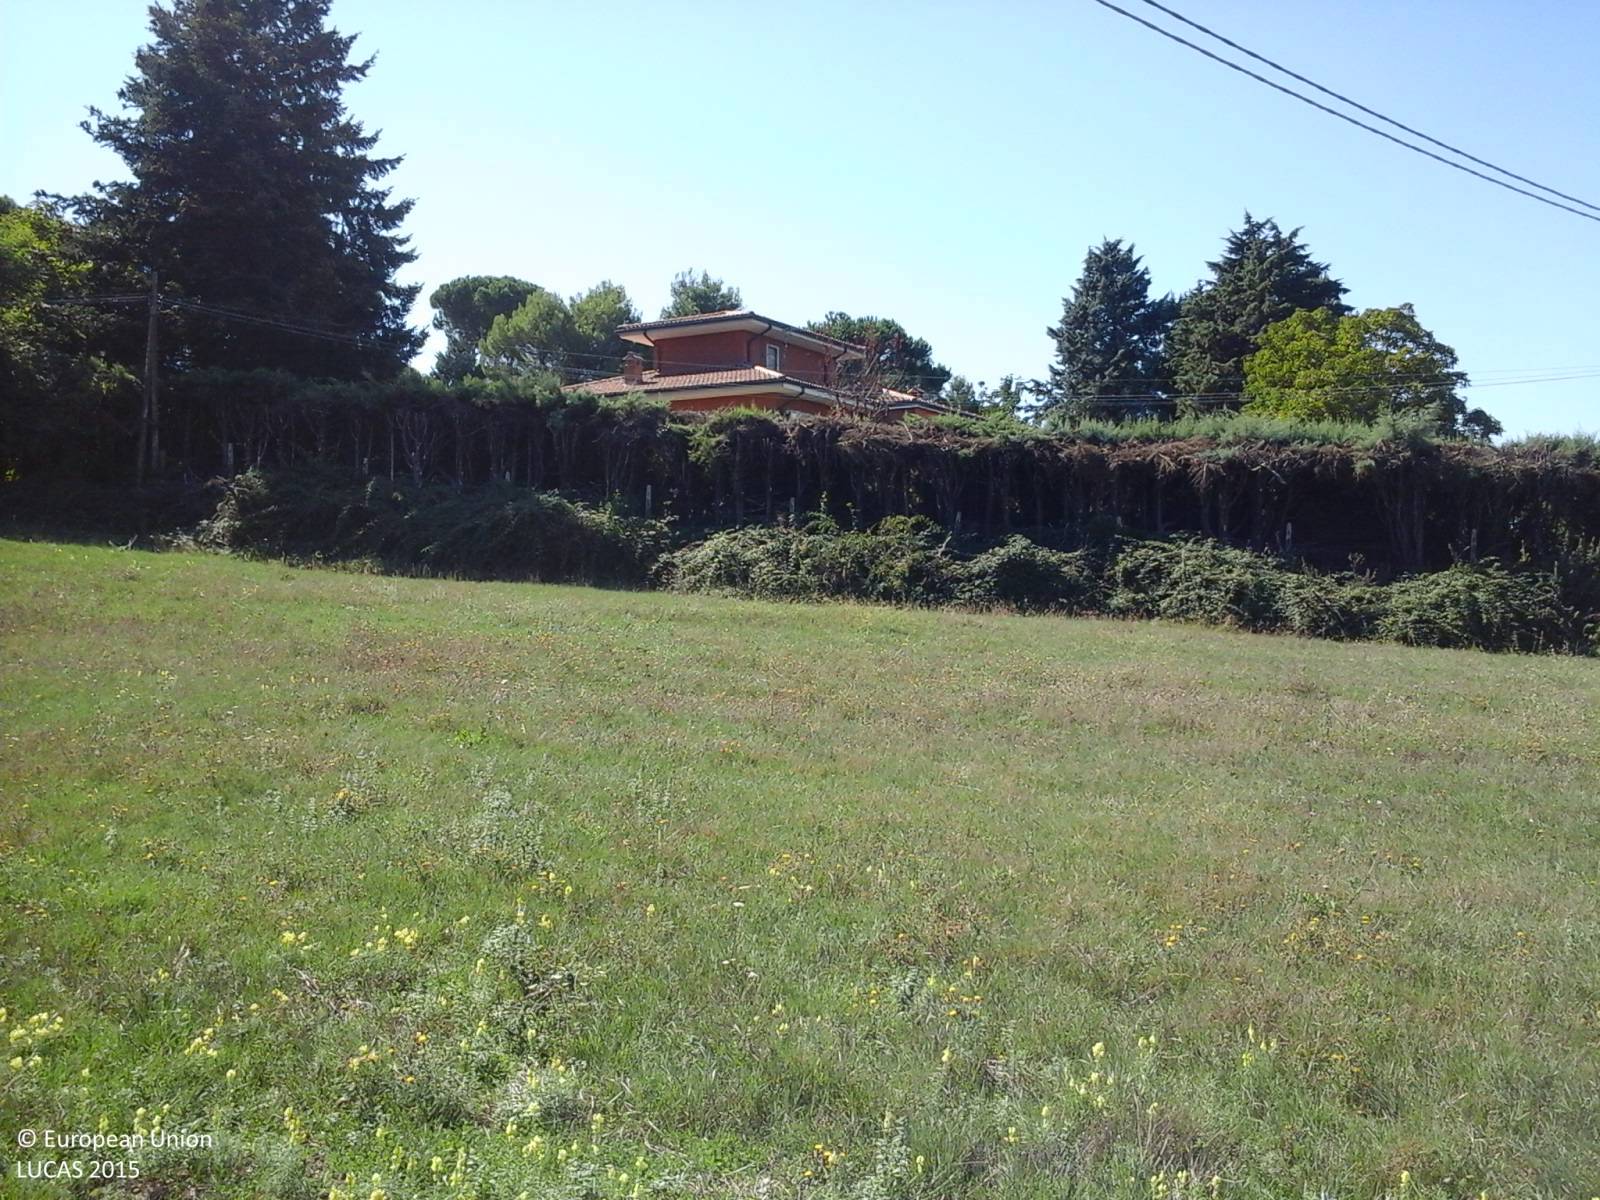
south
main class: Grassland
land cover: Grassland without tree/shrub cover
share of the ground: > 75 %
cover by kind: herbaceous plants 100 %
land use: Agriculture (excluding fallow land and kitchen gardens)
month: September
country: IT
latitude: 42.6874
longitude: 12.0560
